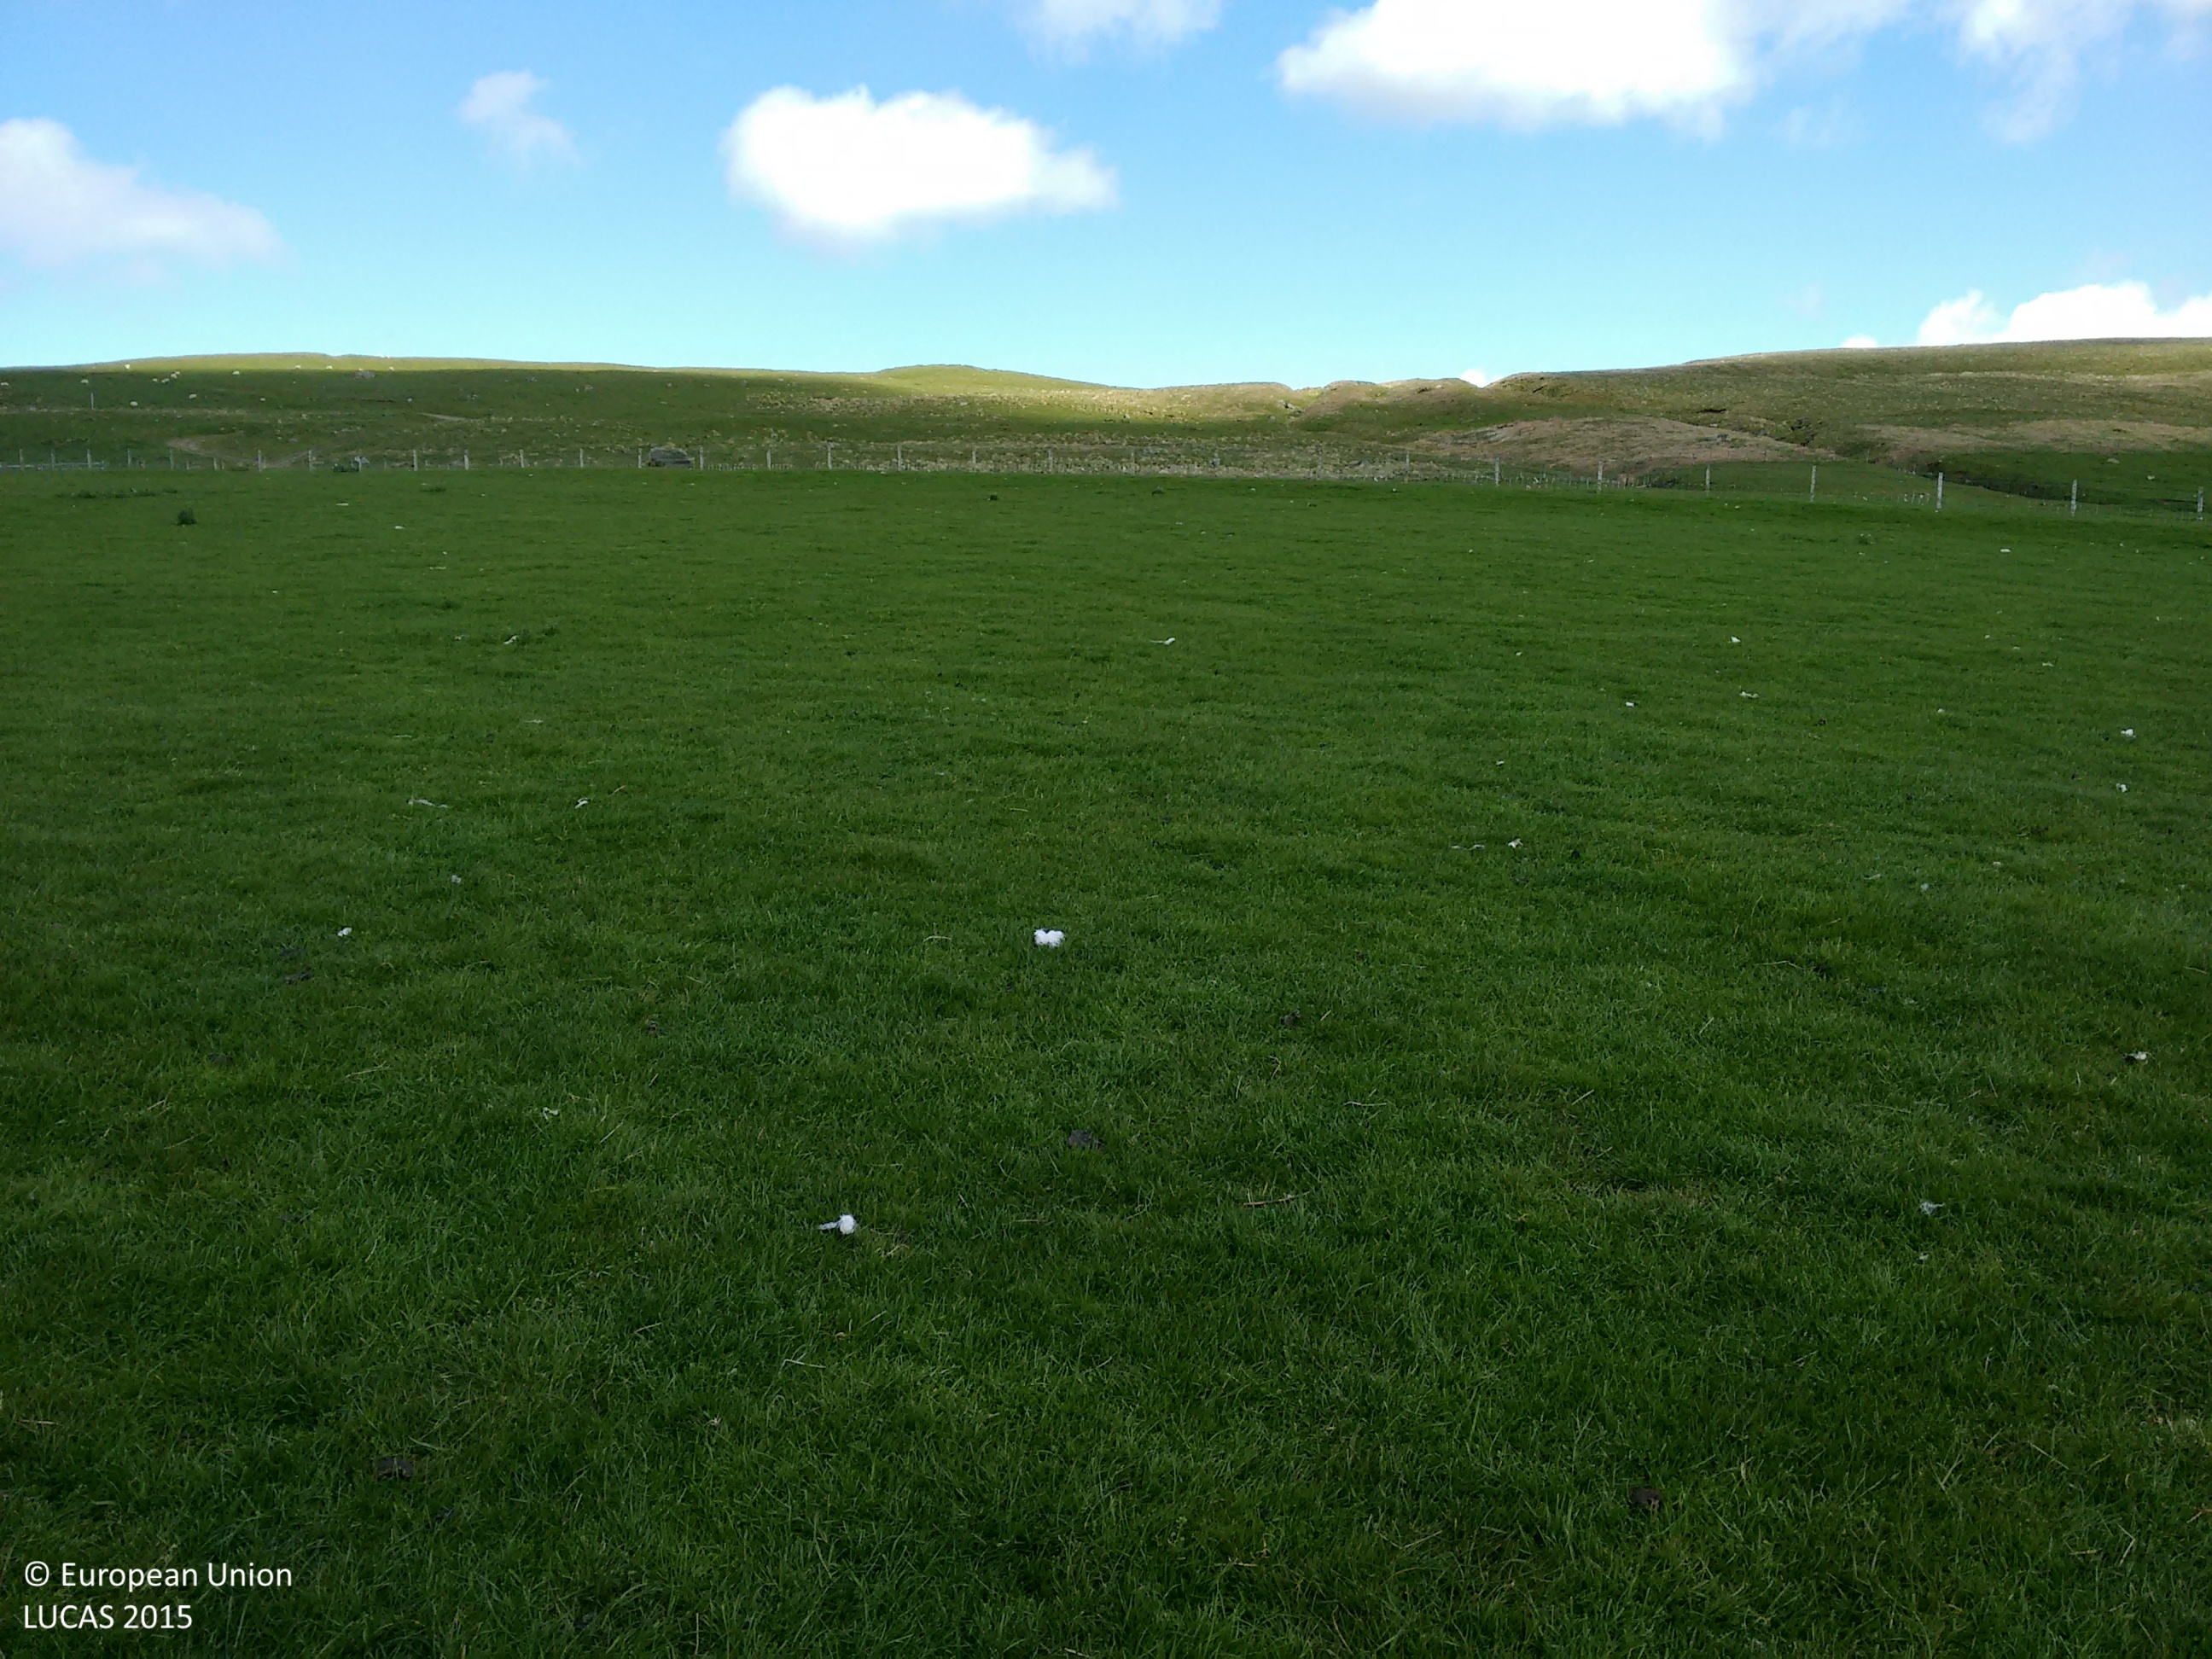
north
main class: Grassland
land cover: Grassland without tree/shrub cover
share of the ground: > 75 %
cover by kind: herbaceous plants 100 %
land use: Agriculture (excluding fallow land and kitchen gardens)
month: June
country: GB
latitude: 56.4226
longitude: -3.8134
